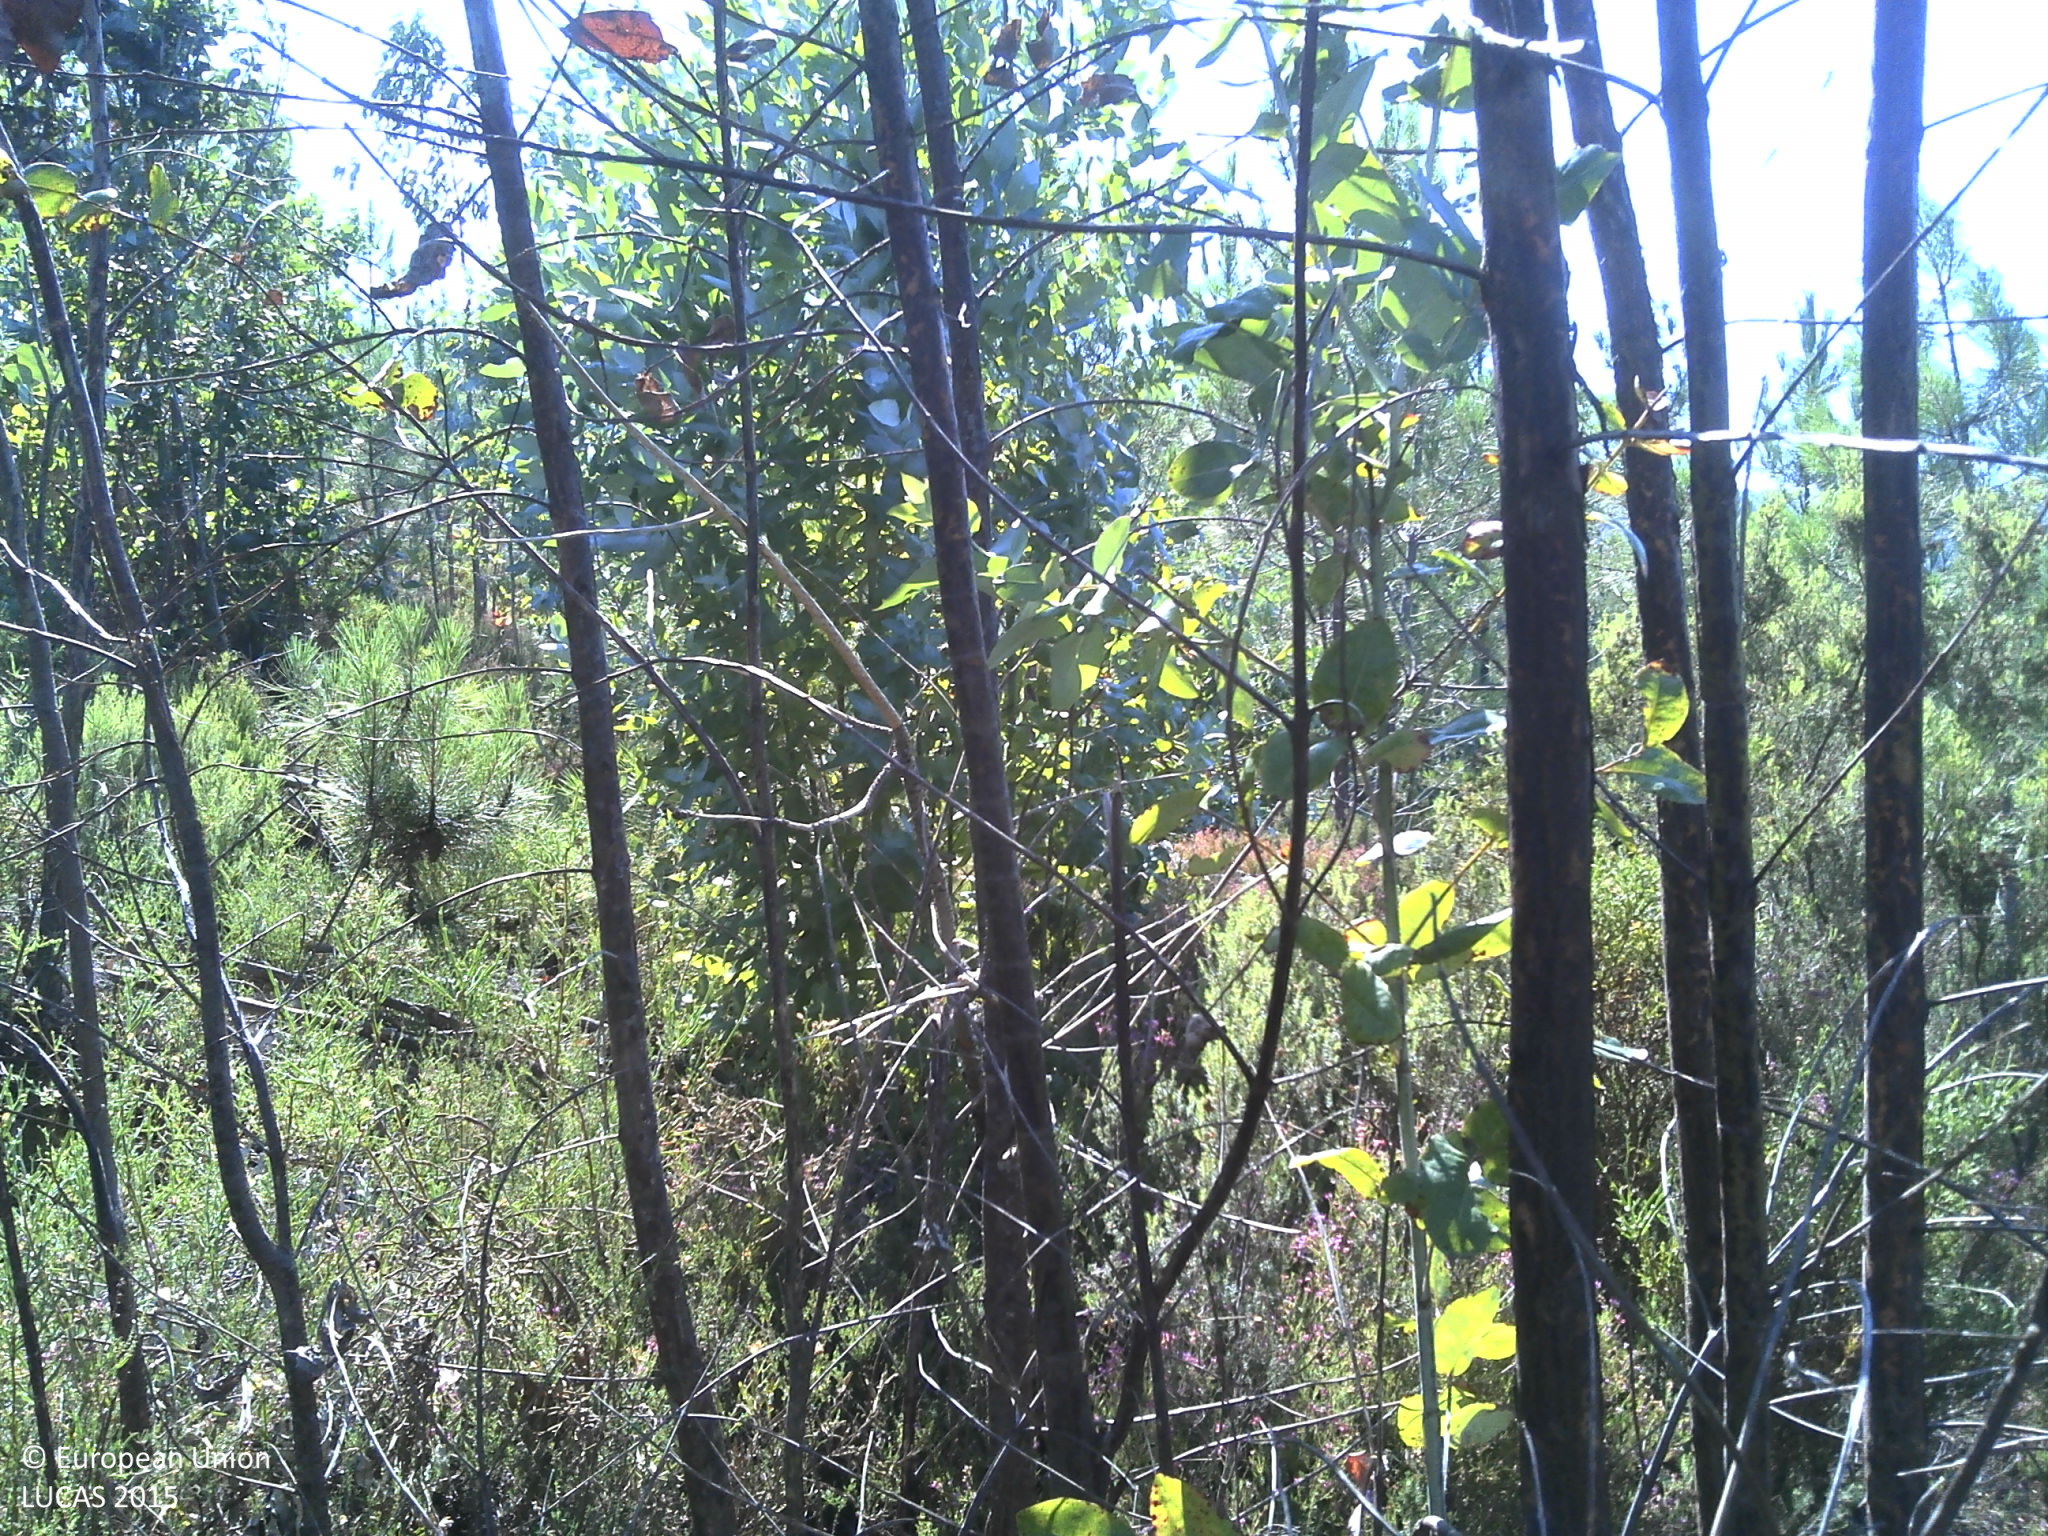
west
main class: Woodland
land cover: Broadleaved woodland
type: exotic forest
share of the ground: 10 - 25 %
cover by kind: shrubs 70 %, broadleaved forest trees 20 %, unconsolidated bare surface 10 %
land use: Forestry
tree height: < 5 m
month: June
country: PT
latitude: 40.0708
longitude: -8.0698
